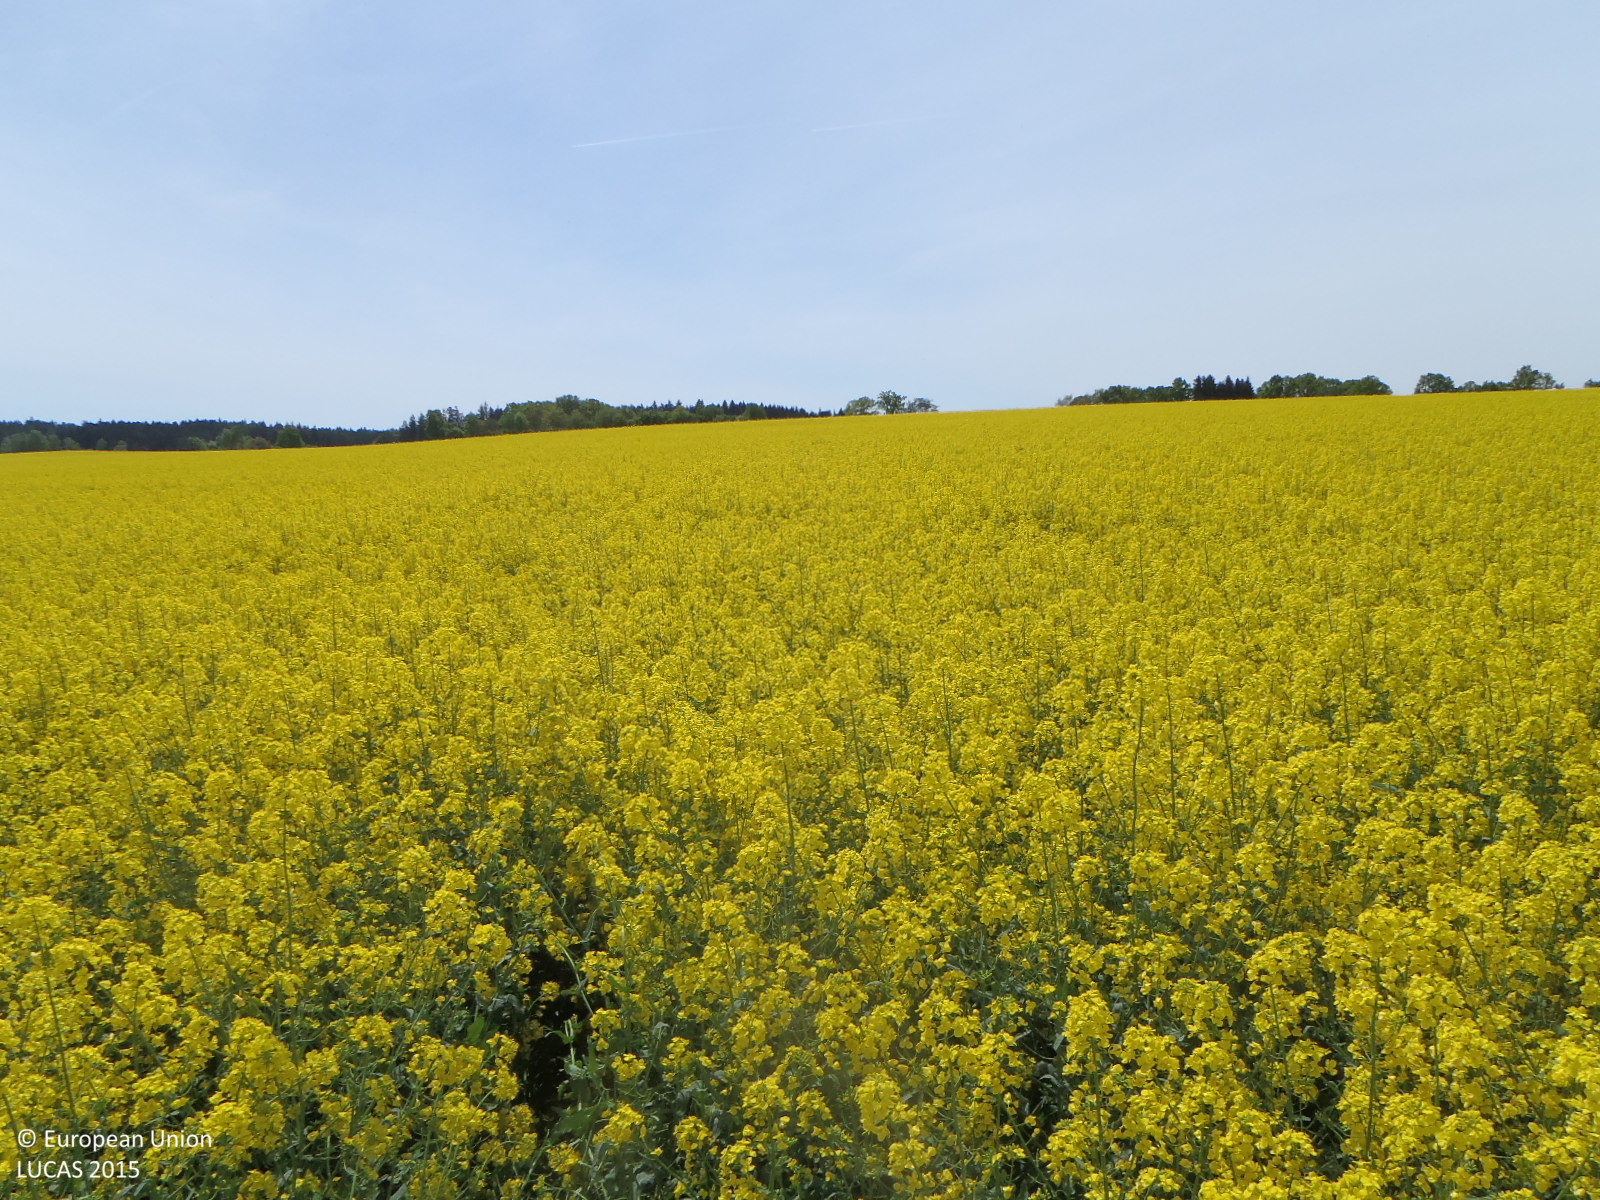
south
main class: Cropland
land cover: Rape and turnip rape
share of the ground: > 75 %
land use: Agriculture (excluding fallow land and kitchen gardens)
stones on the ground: < 10 %
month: May
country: CZ
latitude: 49.1960
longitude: 14.9011
